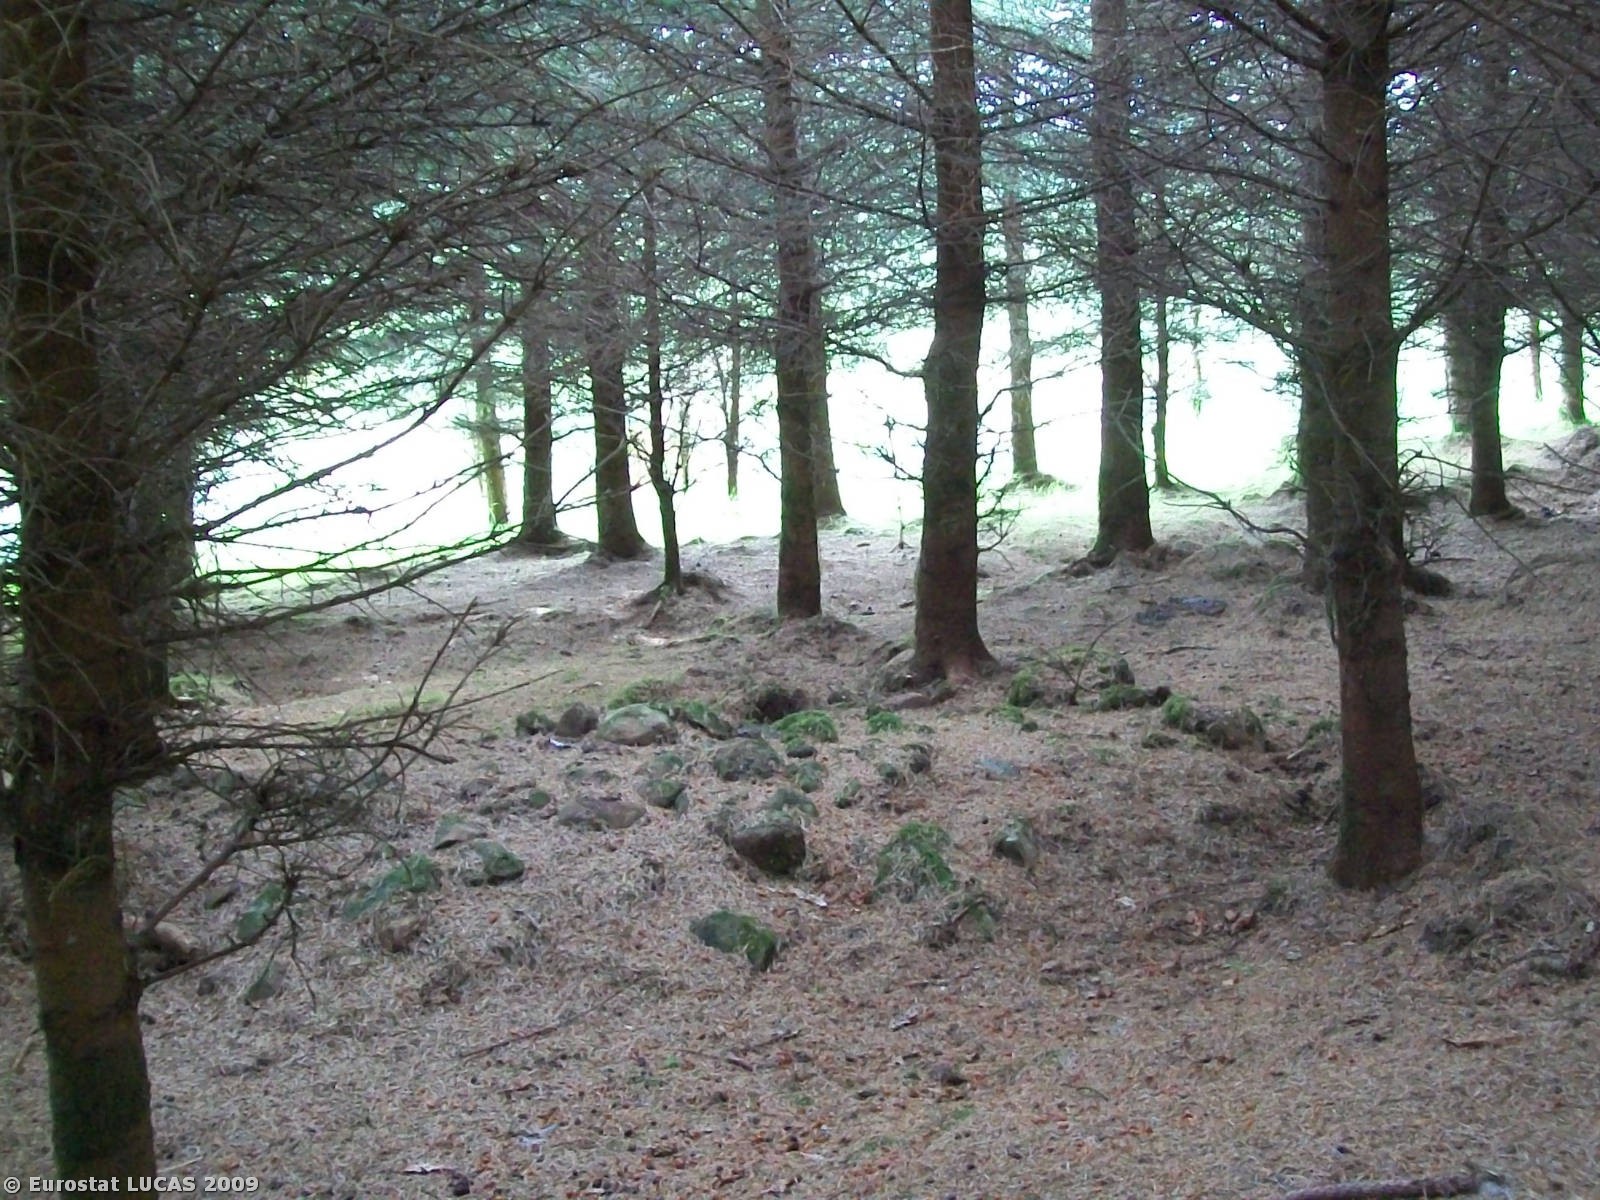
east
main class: Woodland
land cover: Coniferous woodland
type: plantations and self-sown exotic forest
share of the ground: > 75 %
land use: Forestry
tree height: > 5 m
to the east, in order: Coniferous woodland; Grassland without tree/shrub cover; Coniferous woodland; Grassland without tree/shrub cover; Fences; Electric lines; Grass margins; Paved roads, cycling and walking lanes; Grass margins; Fences; Grassland without tree/shrub cover; Broadleaved woodland; Grassland without tree/shrub cover; Rivers and streams; Grassland without tree/shrub cover; Broadleaved woodland; Ditches and canals; Broadleaved woodland; Grass margins; Coniferous woodland
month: July
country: GB
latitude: 54.8975
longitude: -6.8334
